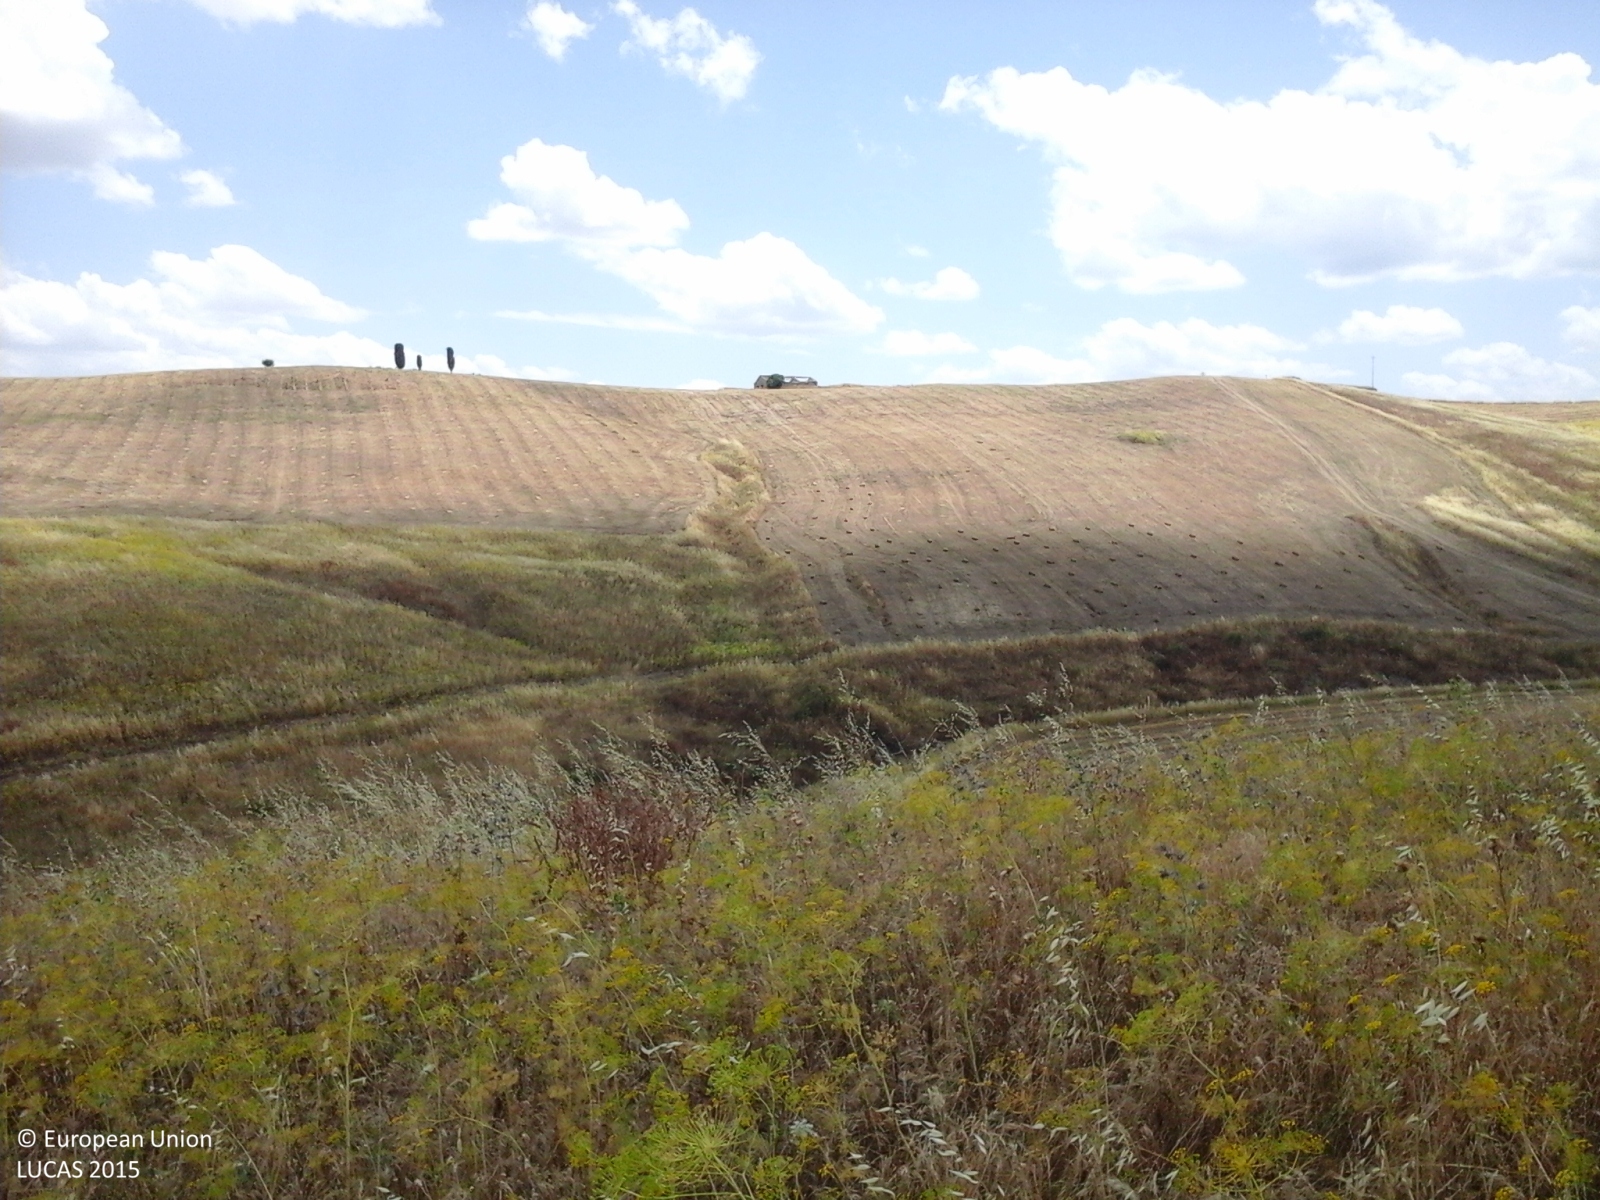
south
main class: Grassland
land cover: Grassland without tree/shrub cover
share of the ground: > 75 %
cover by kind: herbaceous plants 75 %, unconsolidated bare surface 25 %
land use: Agriculture (excluding fallow land and kitchen gardens)
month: June
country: IT
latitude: 37.5540
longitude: 14.4163
